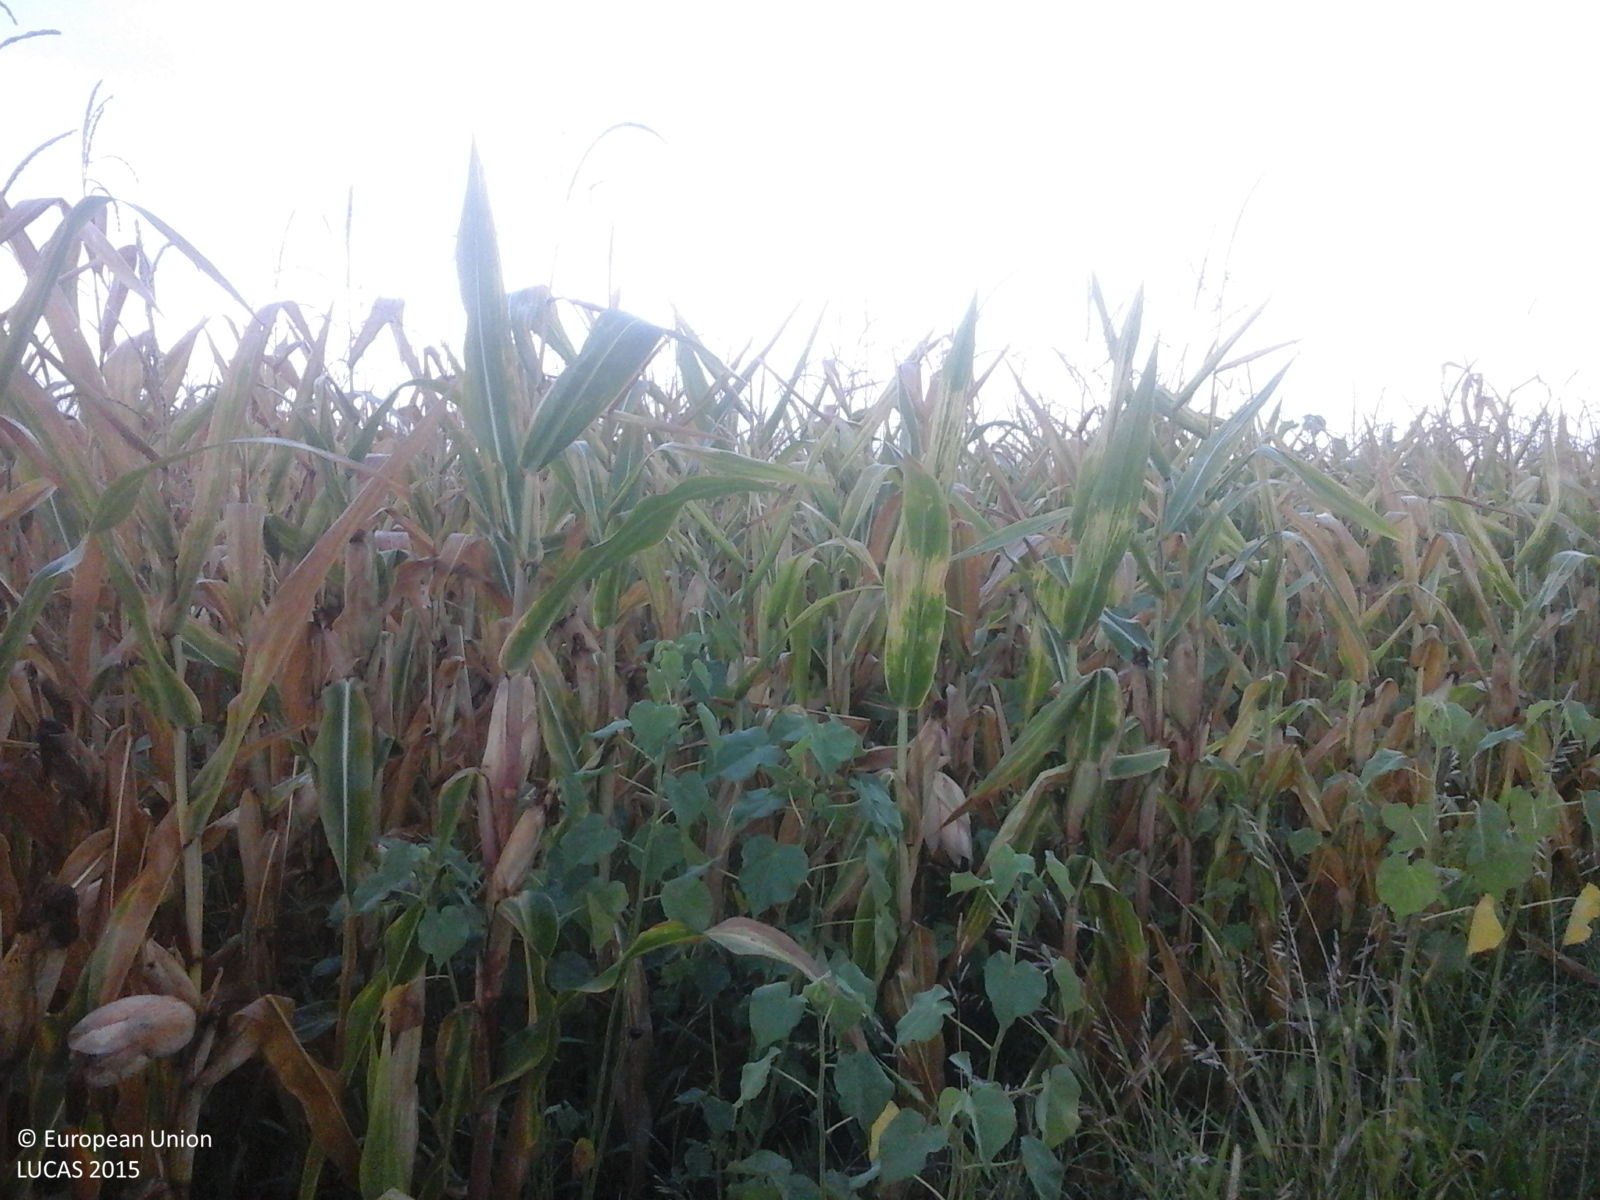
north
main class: Cropland
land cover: Maize
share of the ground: > 75 %
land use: Agriculture (excluding fallow land and kitchen gardens)
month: August
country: RO
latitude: 45.6264
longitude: 21.0976
